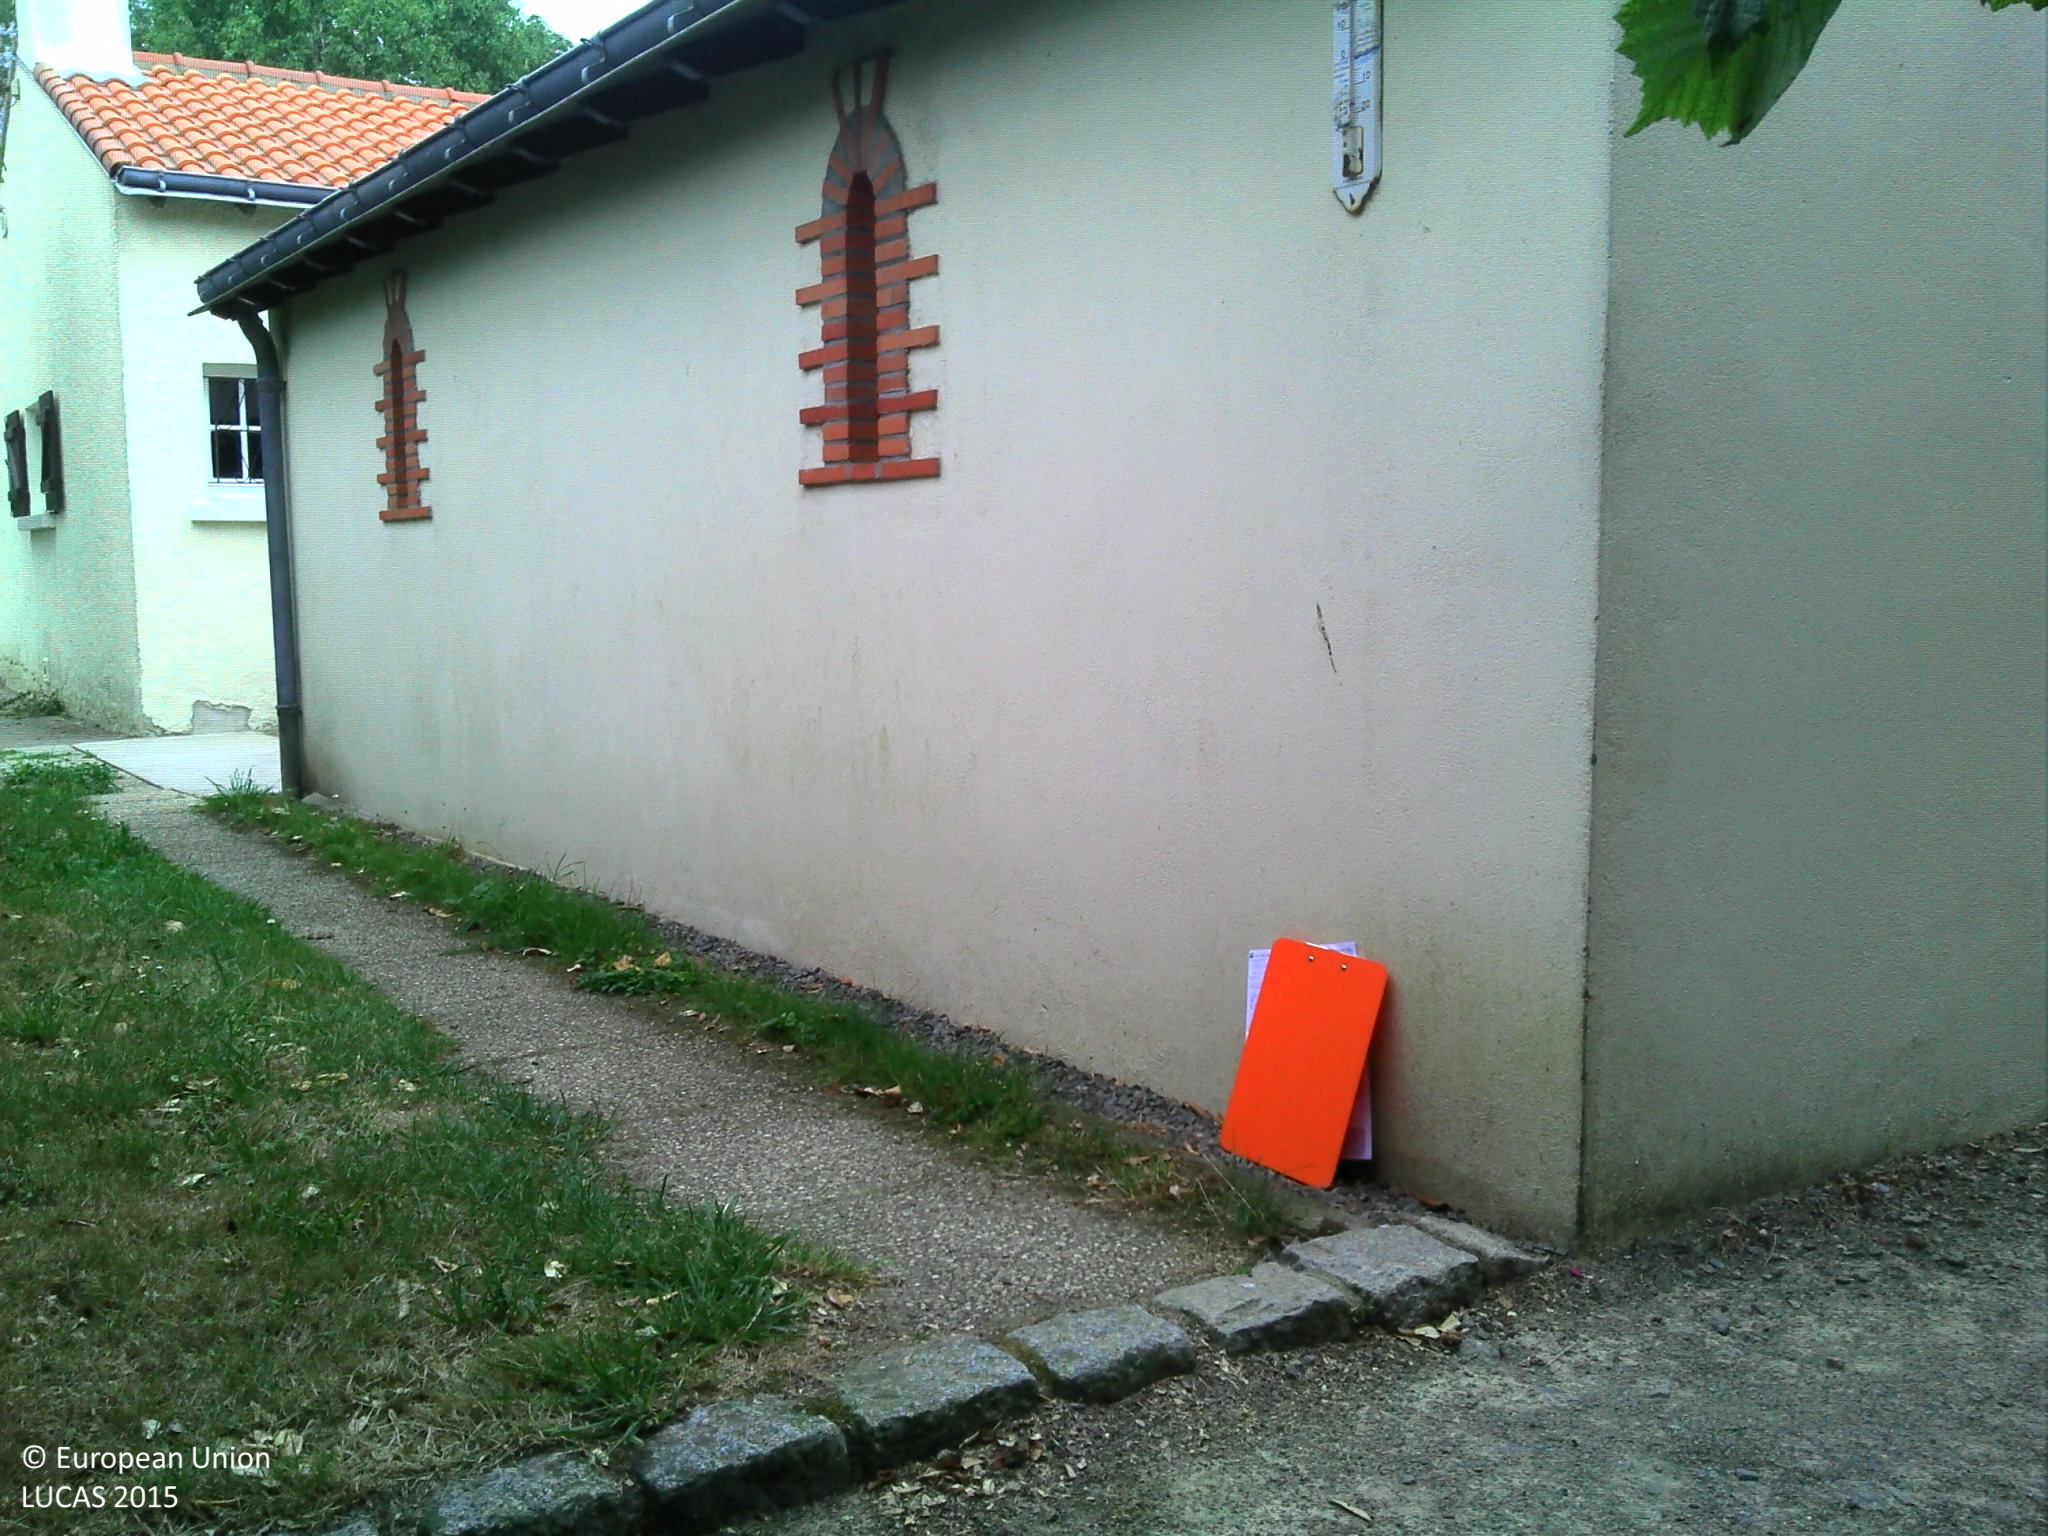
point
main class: Grassland
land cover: Grassland with sparse tree/shrub cover
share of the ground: > 75 %
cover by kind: herbaceous plants 95 %, broadleaved forest trees 5 %
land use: Residential
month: July
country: FR
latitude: 47.1449
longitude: -1.6874
